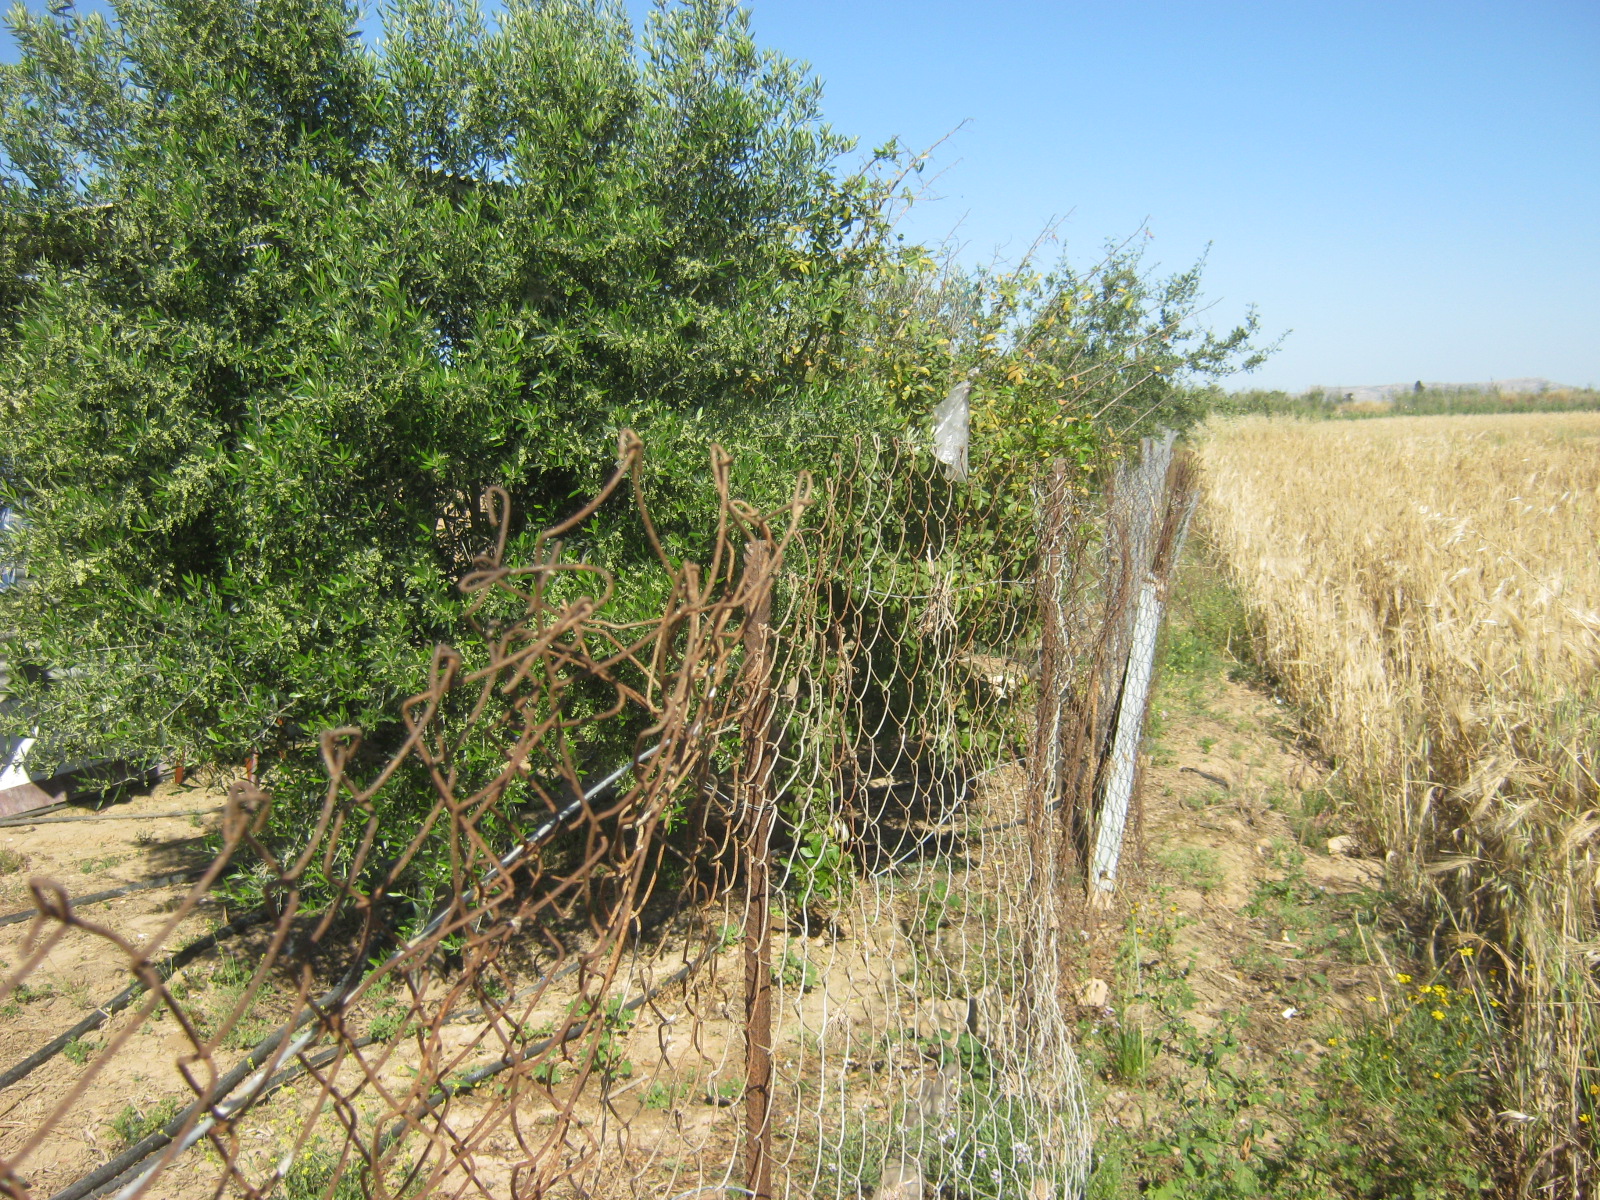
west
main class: Grassland
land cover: Spontaneously vegetated surfaces
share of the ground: > 75 %
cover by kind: herbaceous plants 90 %, unconsolidated bare surface 10 %
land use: Agriculture (excluding fallow land and kitchen gardens)
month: May
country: CY
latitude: 35.1601
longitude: 33.2545
